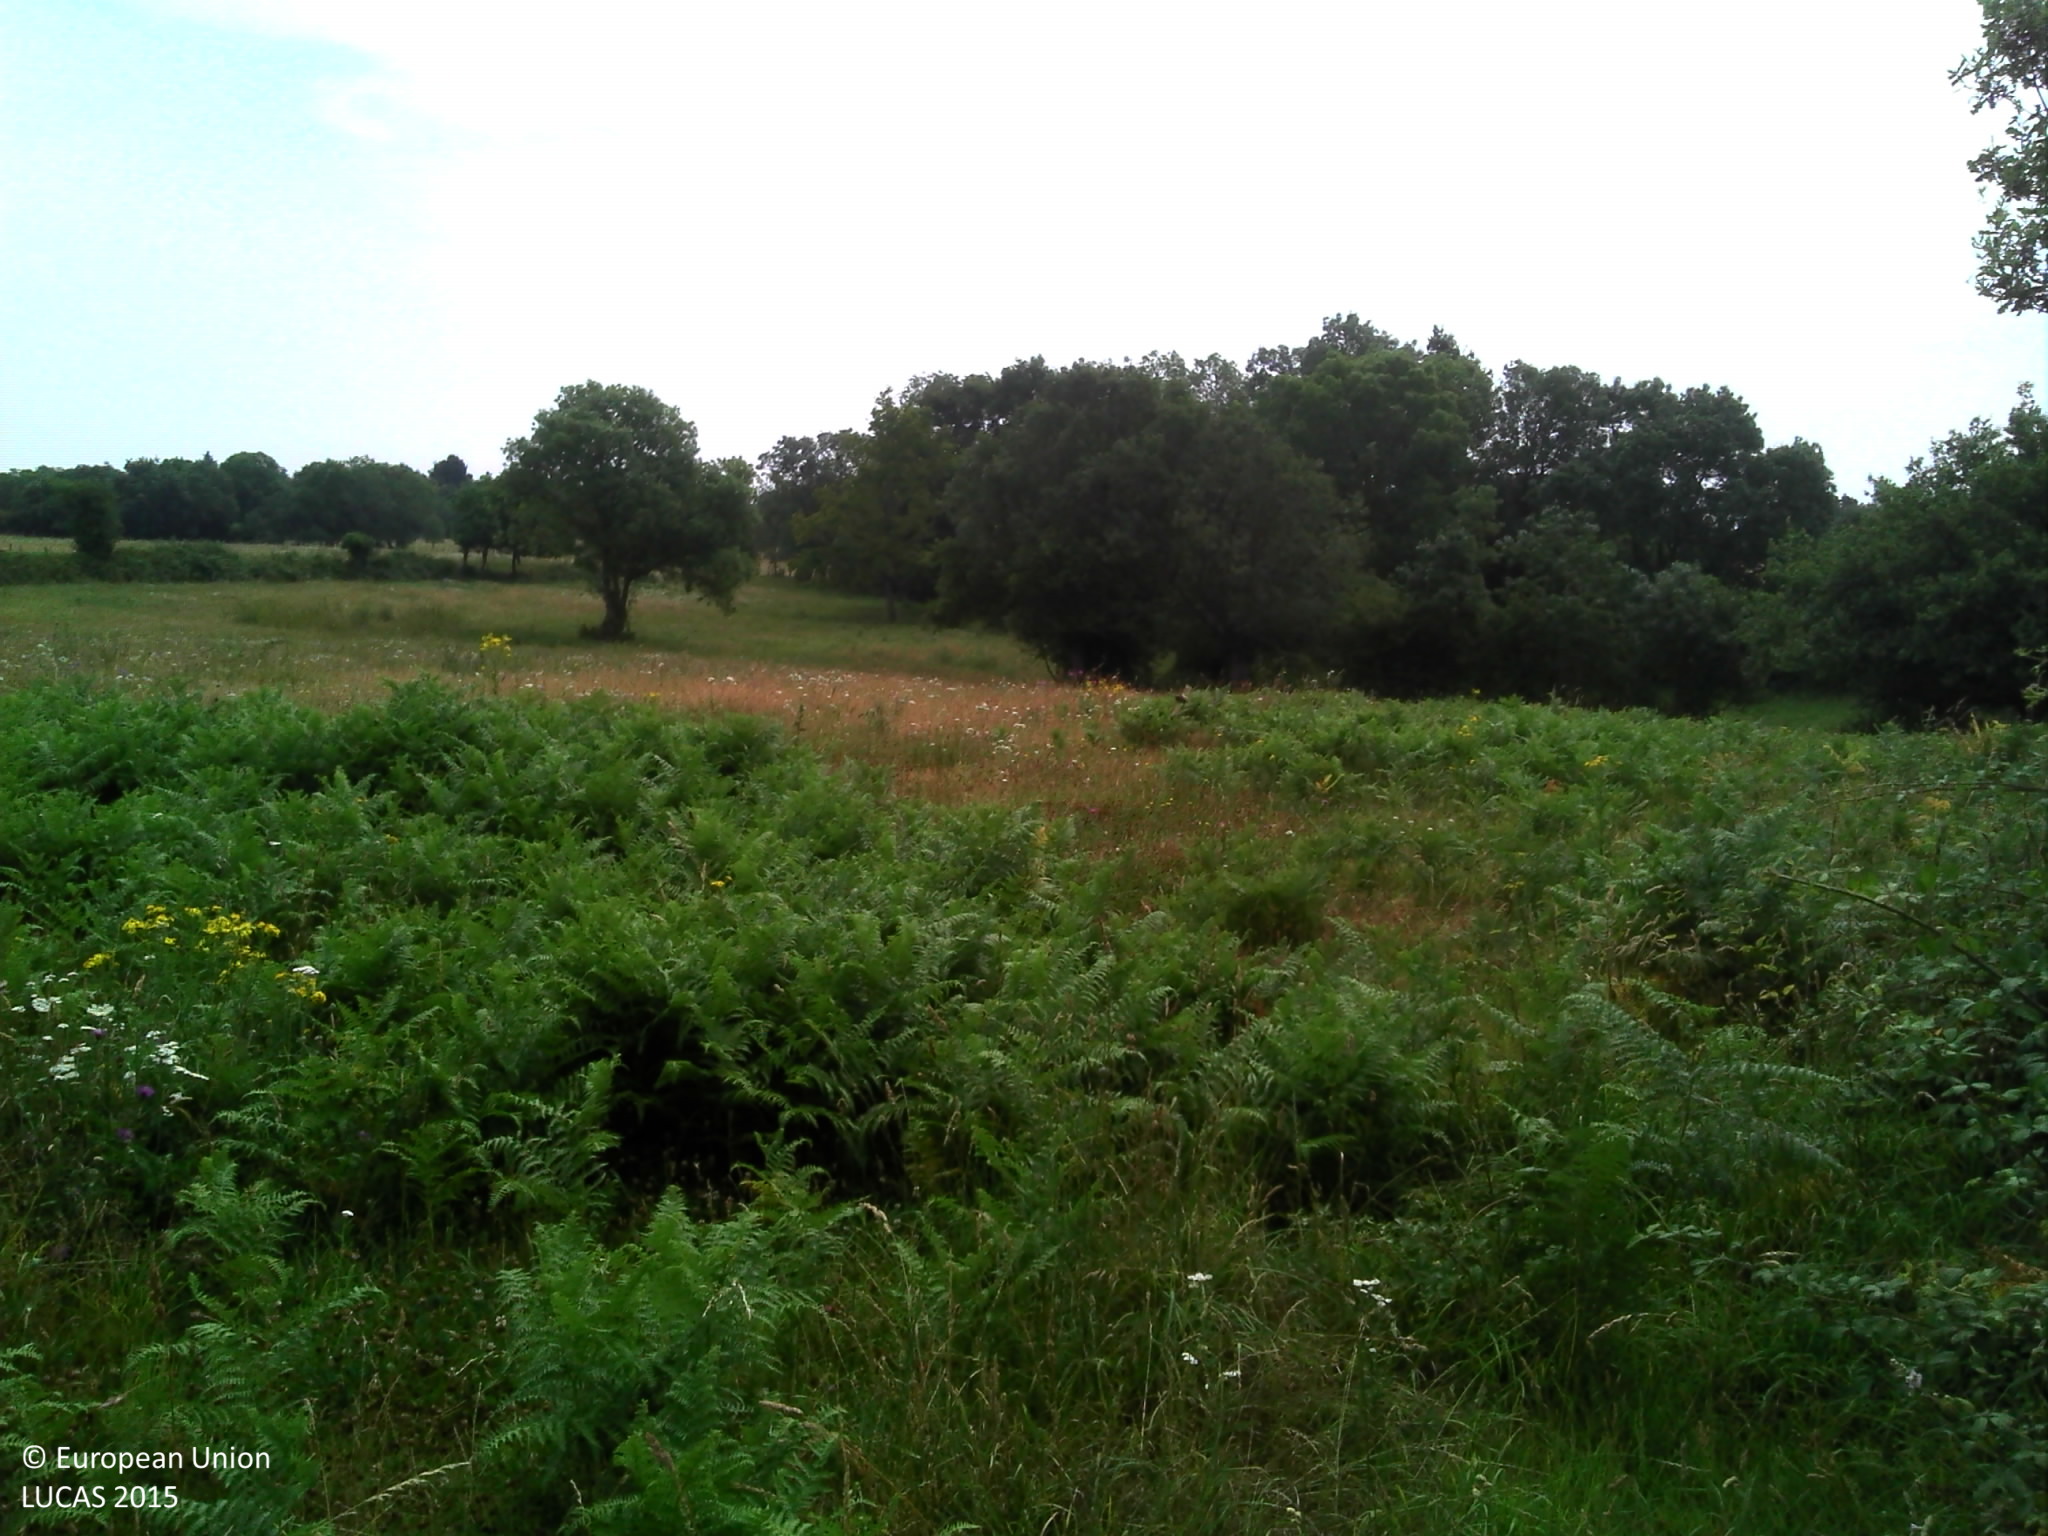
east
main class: Grassland
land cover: Grassland with sparse tree/shrub cover
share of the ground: > 75 %
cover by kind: herbaceous plants 95 %, broadleaved forest trees 5 %
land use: Agriculture (excluding fallow land and kitchen gardens)
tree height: > 5 m
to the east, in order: Abandoned hedges; Fences; Grassland with sparse tree/shrub cover; Fences; Lines of trees; Grassland with sparse tree/shrub cover
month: July
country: FR
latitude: 47.2663
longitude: -1.7417
